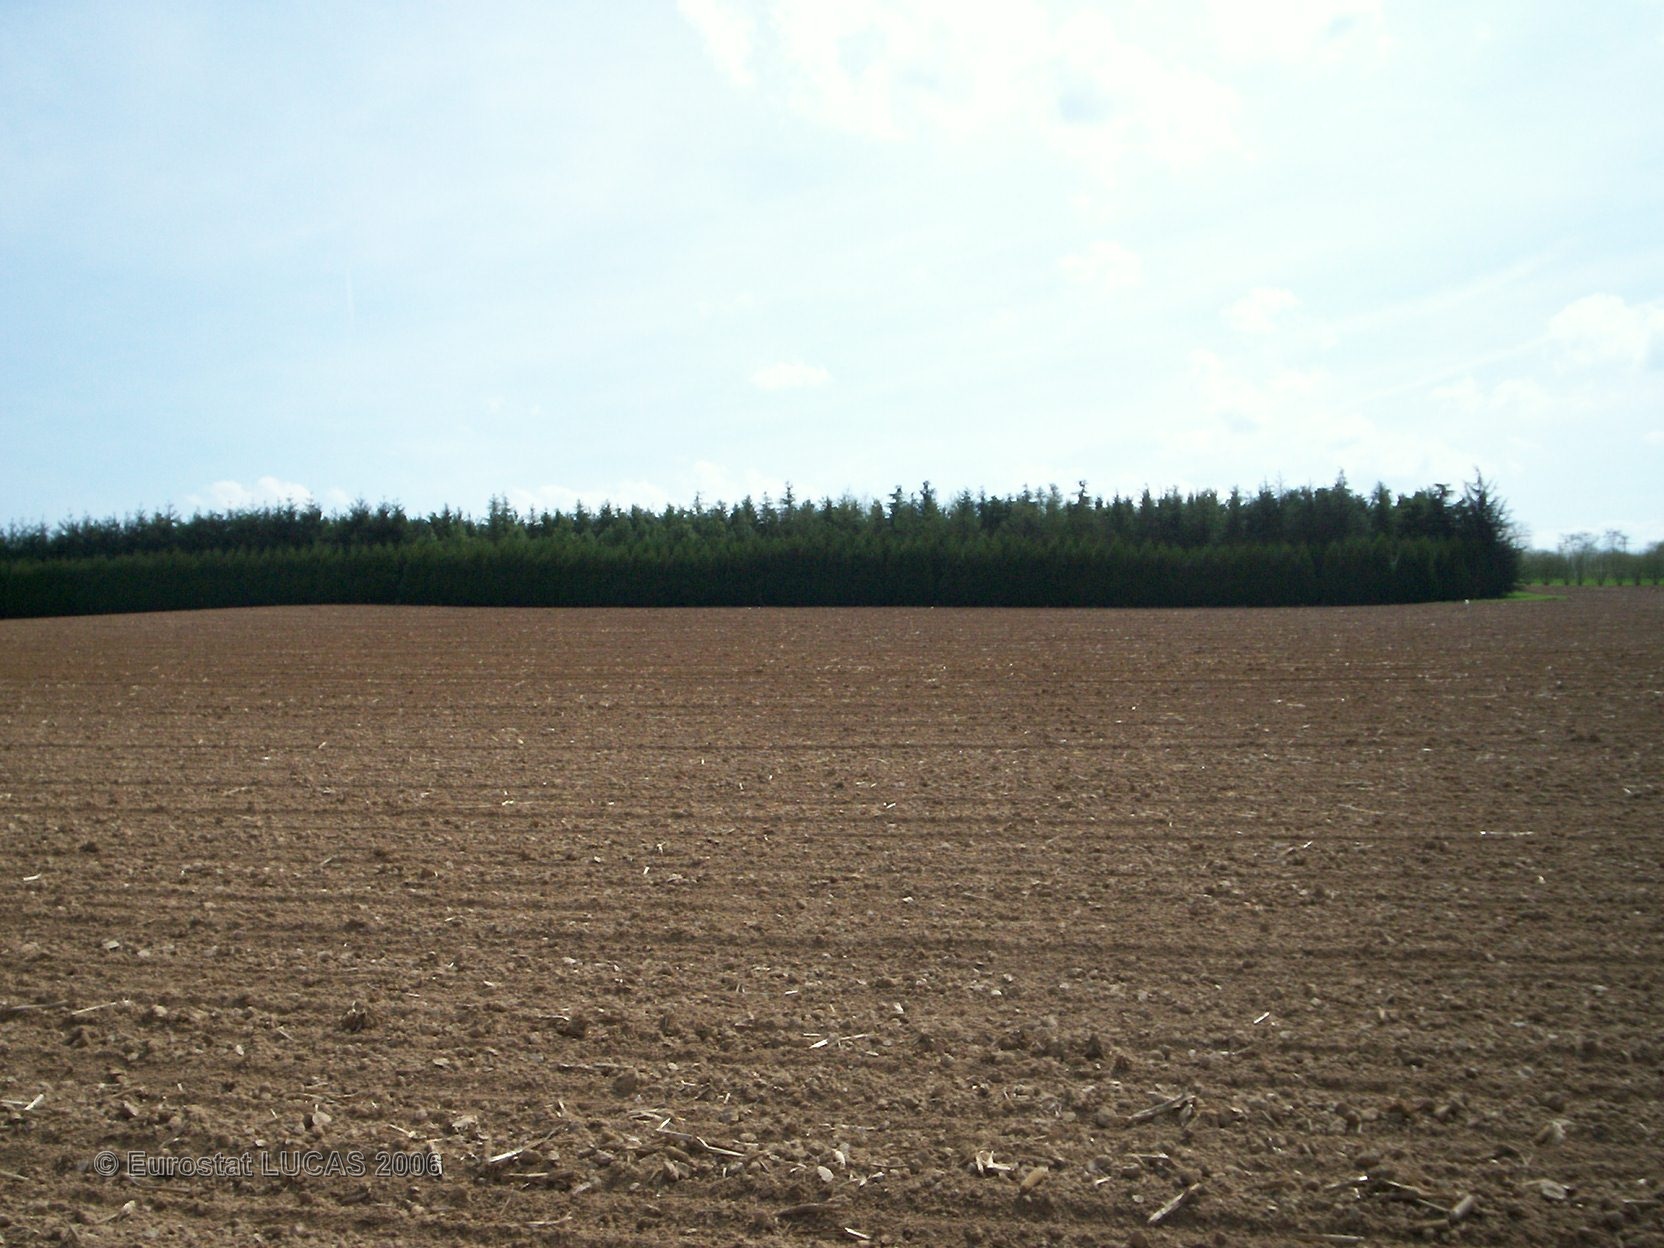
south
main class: Cropland
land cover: Sugar beet
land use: Agriculture (excluding fallow land and kitchen gardens)
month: April
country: FR
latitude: 48.3400
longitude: 2.9359
